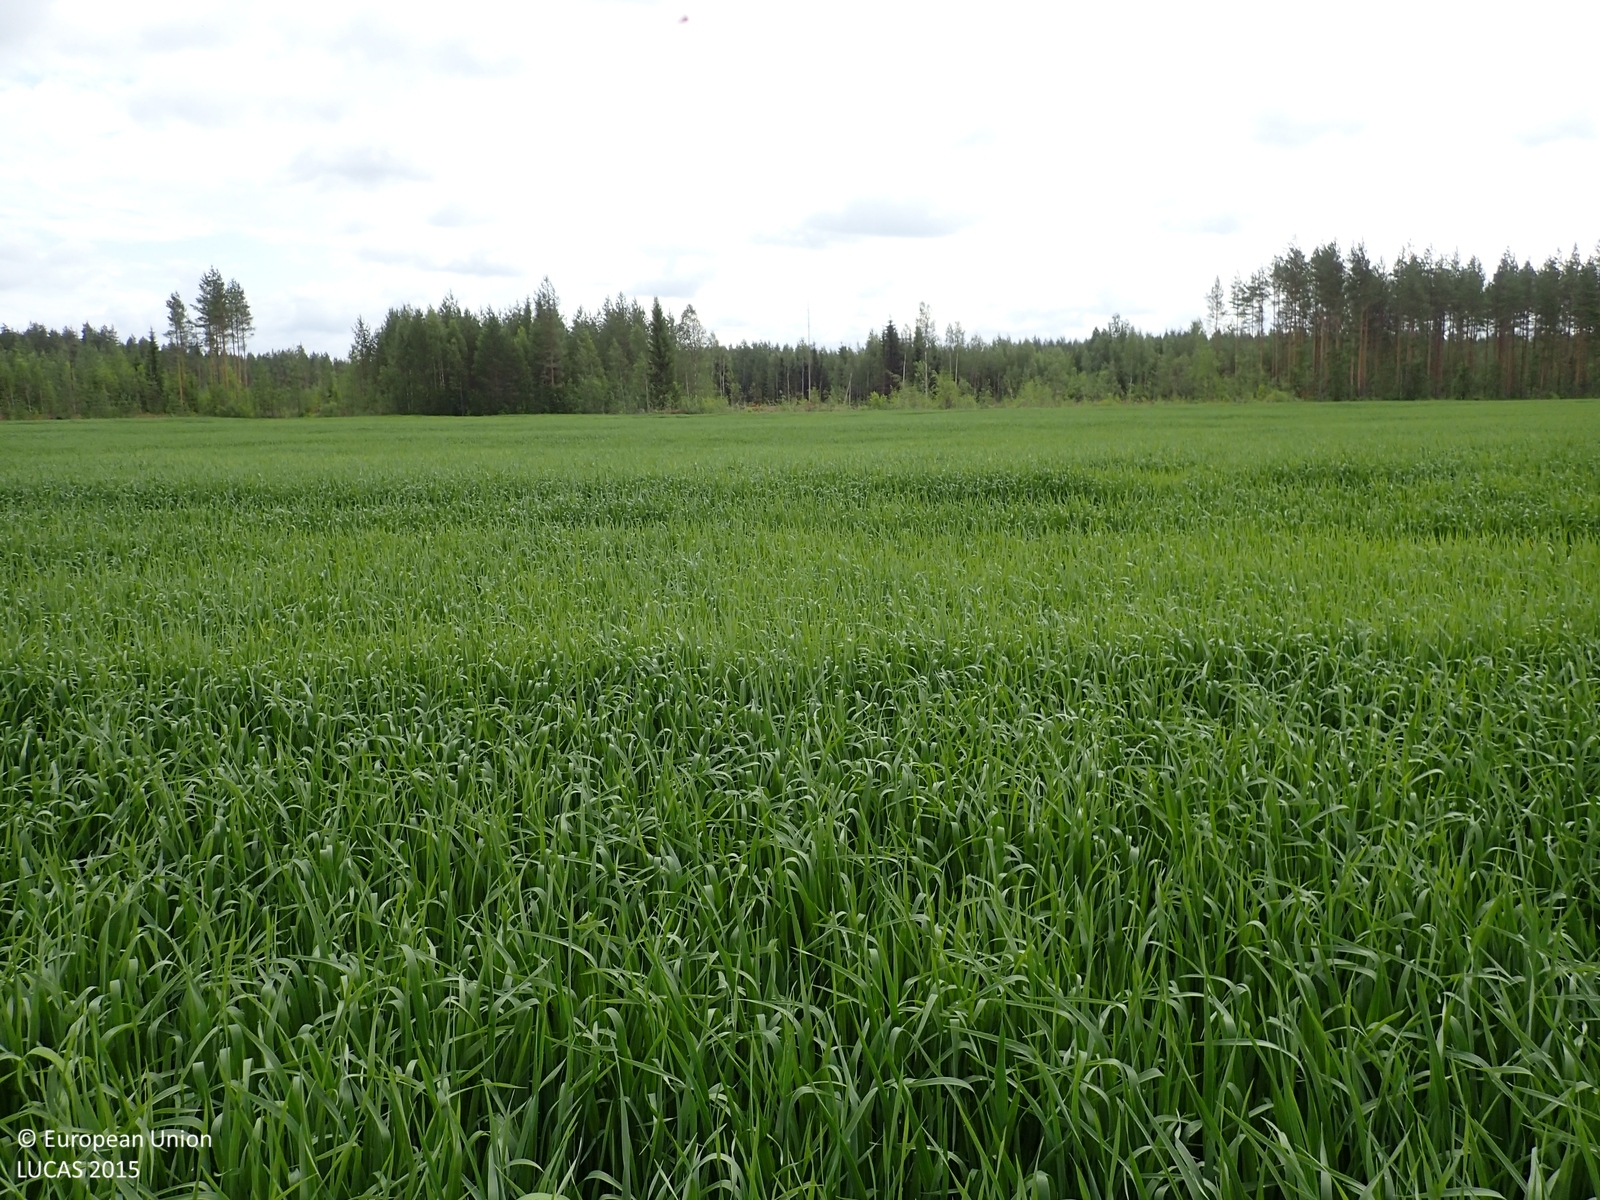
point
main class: Cropland
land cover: Oats
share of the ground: > 75 %
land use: Agriculture (excluding fallow land and kitchen gardens)
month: July
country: FI
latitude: 62.9163
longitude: 23.3139
